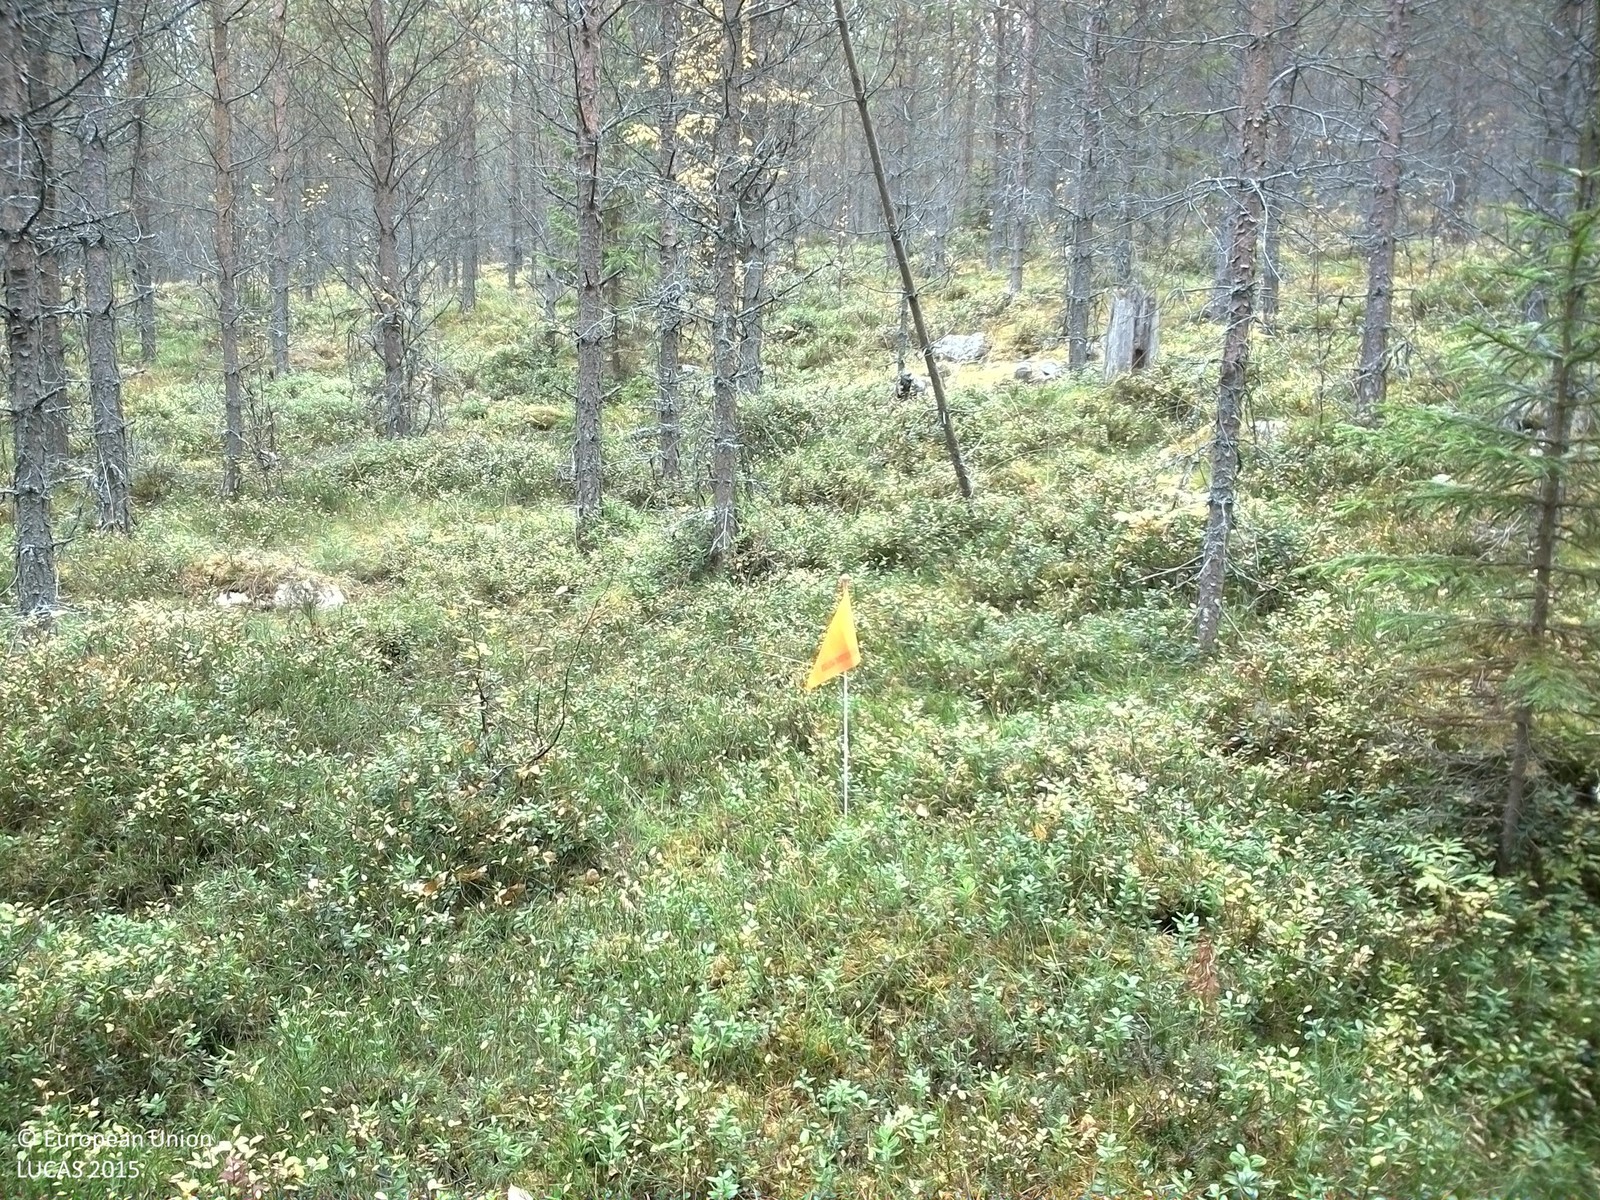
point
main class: Woodland
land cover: Pine dominated coniferous woodland
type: boreal forest
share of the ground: > 75 %
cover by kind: coniferous forest trees 75 %, shrubs 20 %, lichens and mosses 5 %
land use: Forestry
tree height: > 5 m
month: October
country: SE
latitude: 61.4317
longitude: 14.8774
